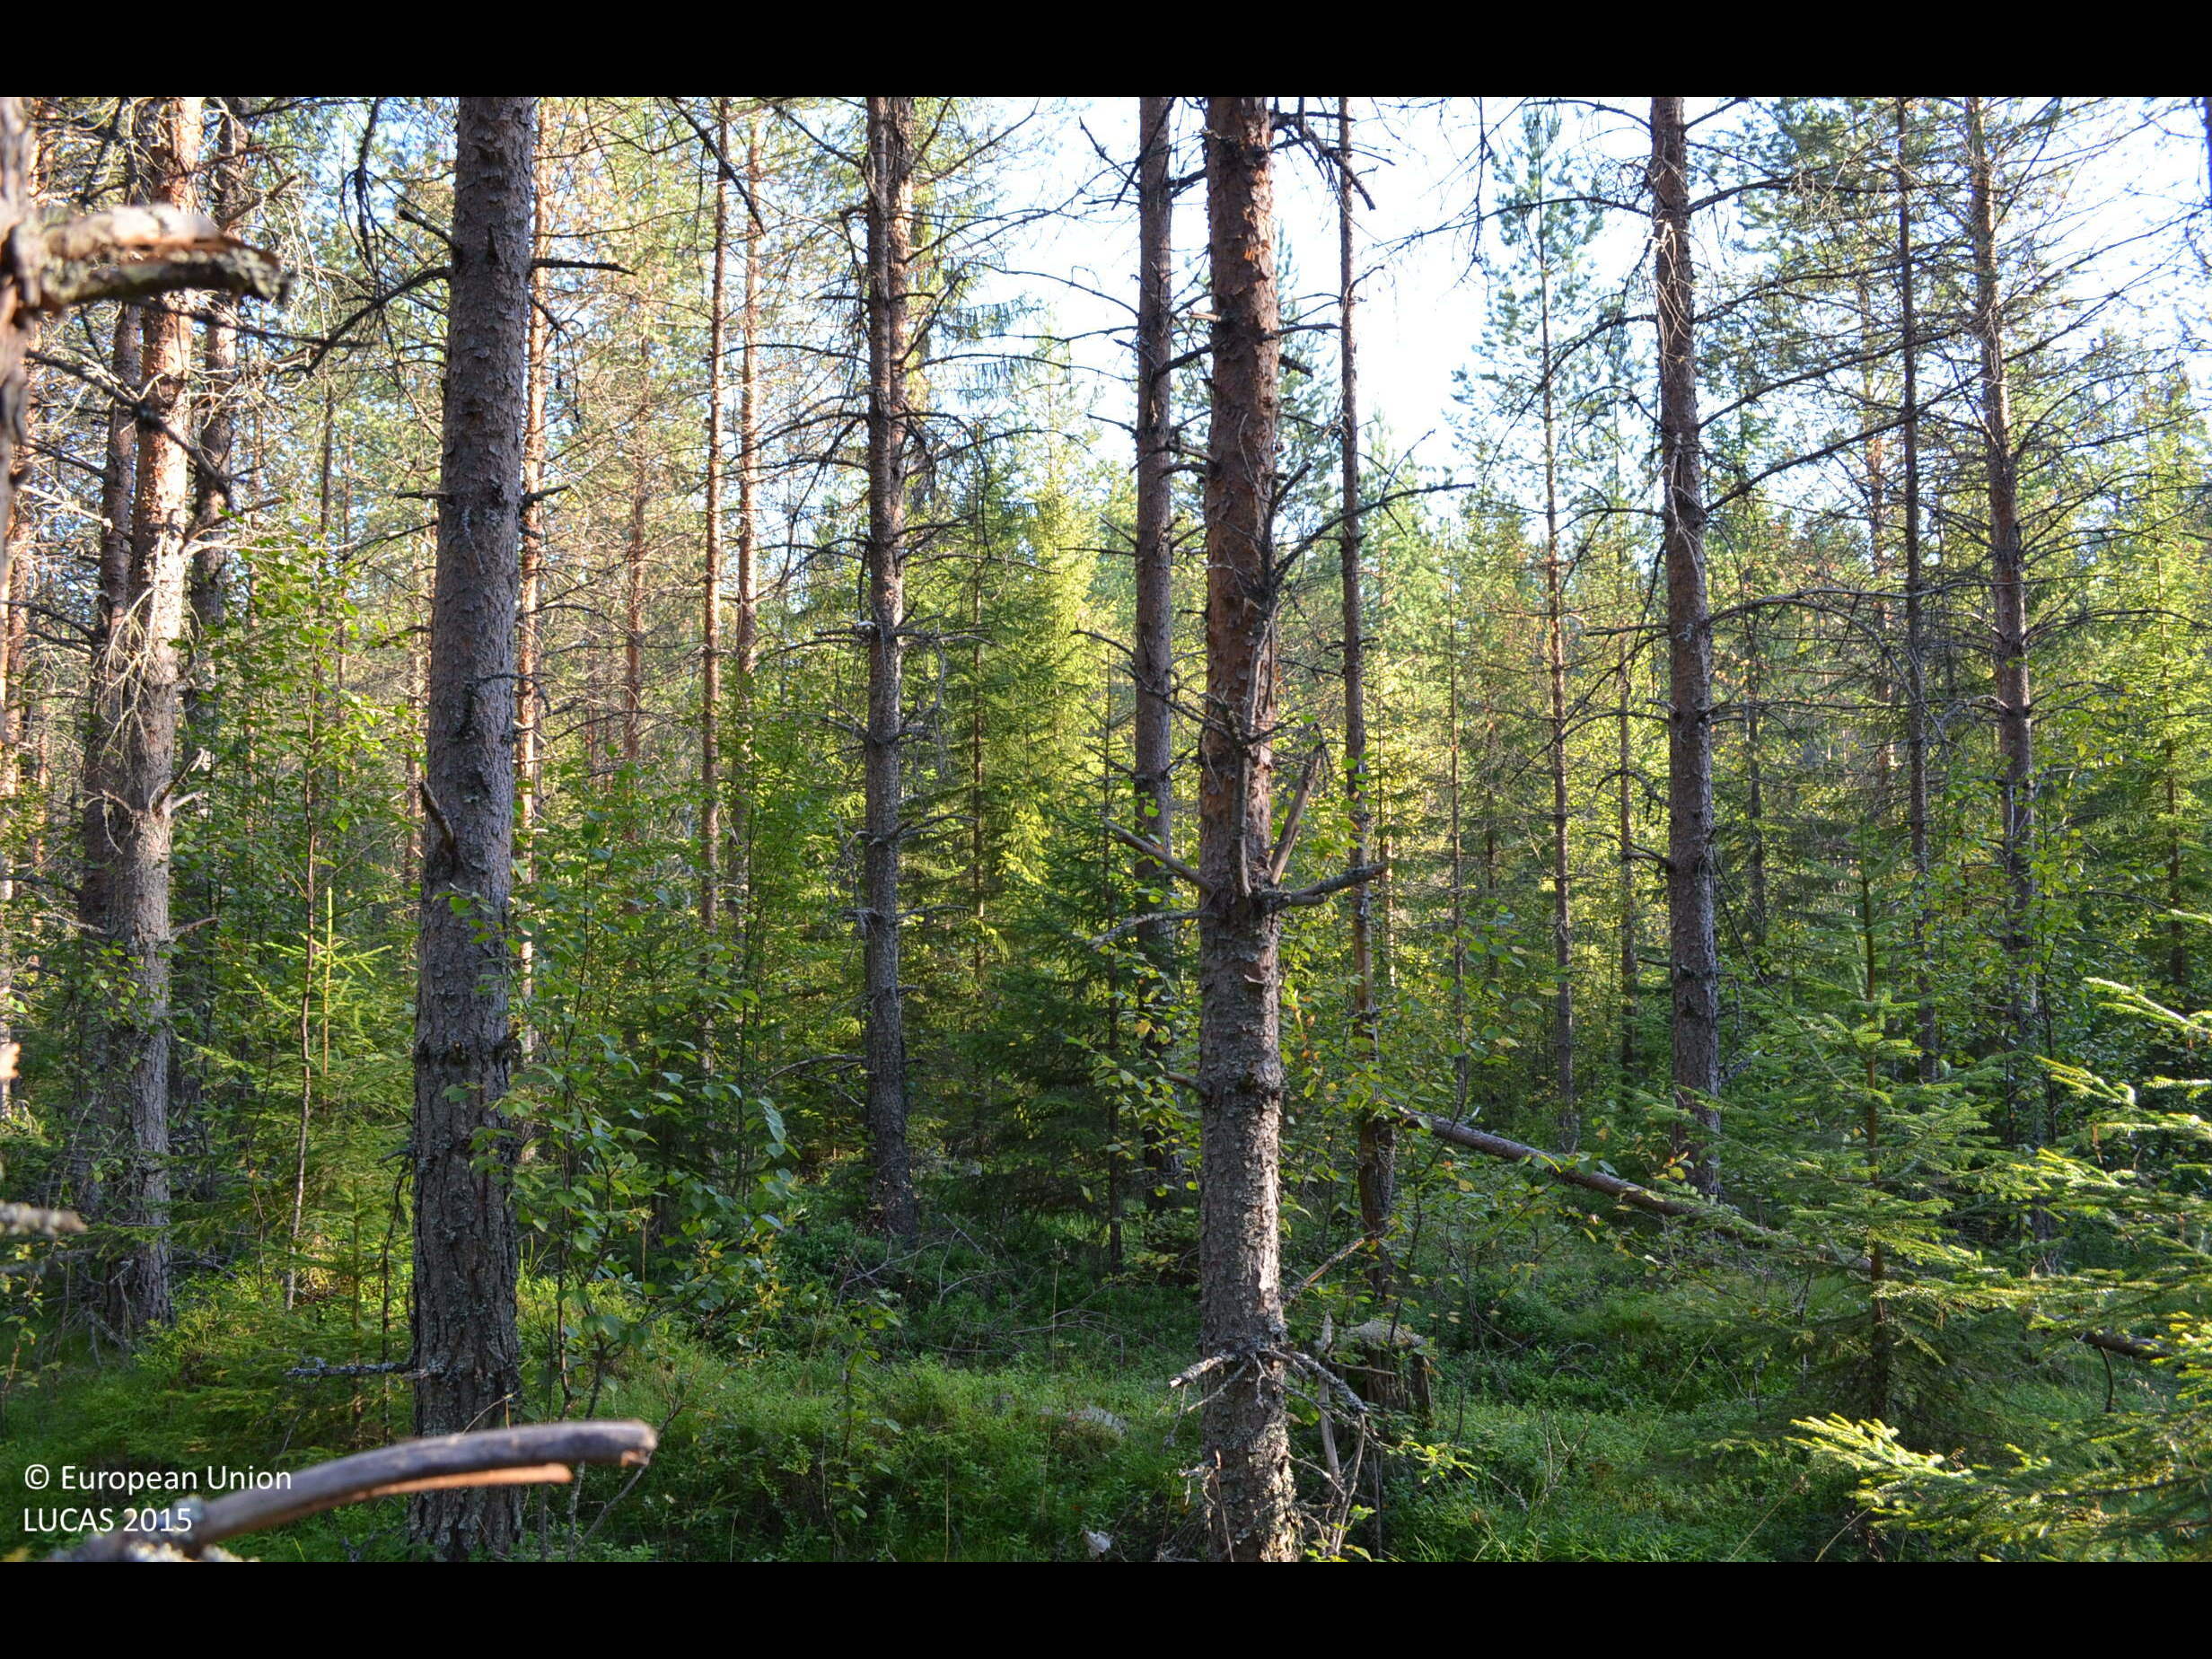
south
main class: Woodland
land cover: Pine dominated coniferous woodland
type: boreal forest
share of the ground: > 75 %
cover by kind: coniferous forest trees 70 %, broadleaved forest trees 10 %, shrubs 10 %, herbaceous plants 10 %
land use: Forestry
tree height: > 5 m
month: August
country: FI
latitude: 62.5316
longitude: 24.4891
